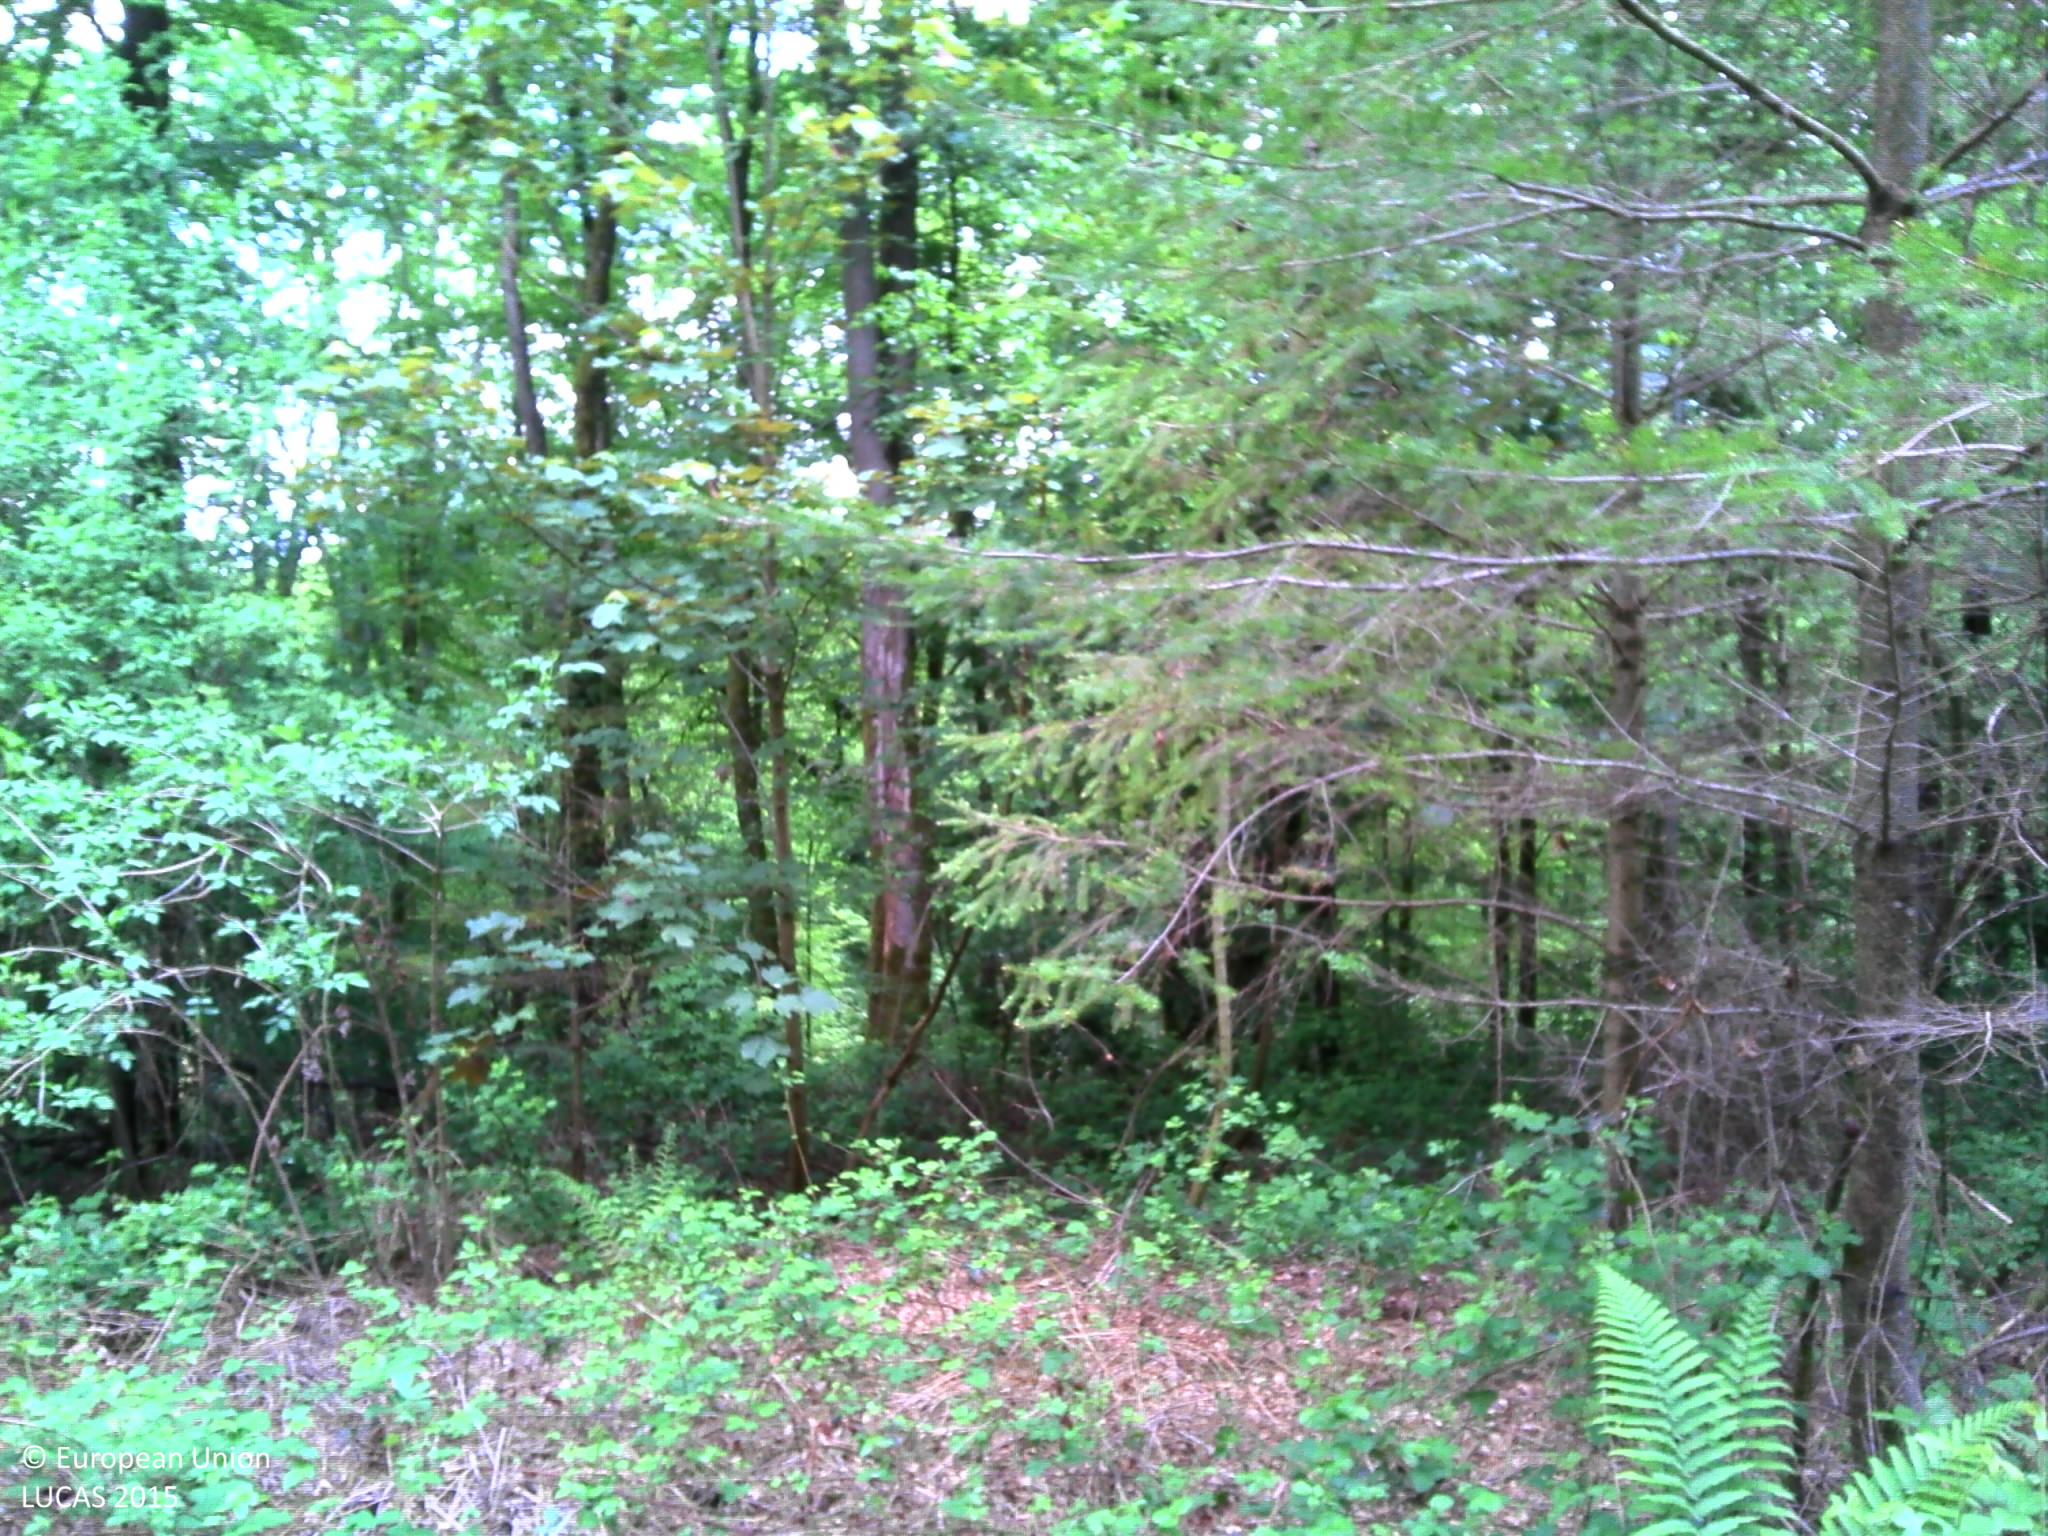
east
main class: Woodland
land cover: Other mixed woodland
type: hemiboreal forest and nemoral coniferous forest and mixed broadleaved-coniferous forest
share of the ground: > 75 %
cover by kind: broadleaved forest trees 60 %, coniferous forest trees 40 %
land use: Forestry
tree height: > 5 m
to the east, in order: Other mixed woodland; Tracks; Broadleaved woodland; Tracks; Spruce dominated coniferous woodland; Broadleaved woodland; Ditches and canals; Spruce dominated coniferous woodland
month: May
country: LU
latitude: 49.6827
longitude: 6.0215
